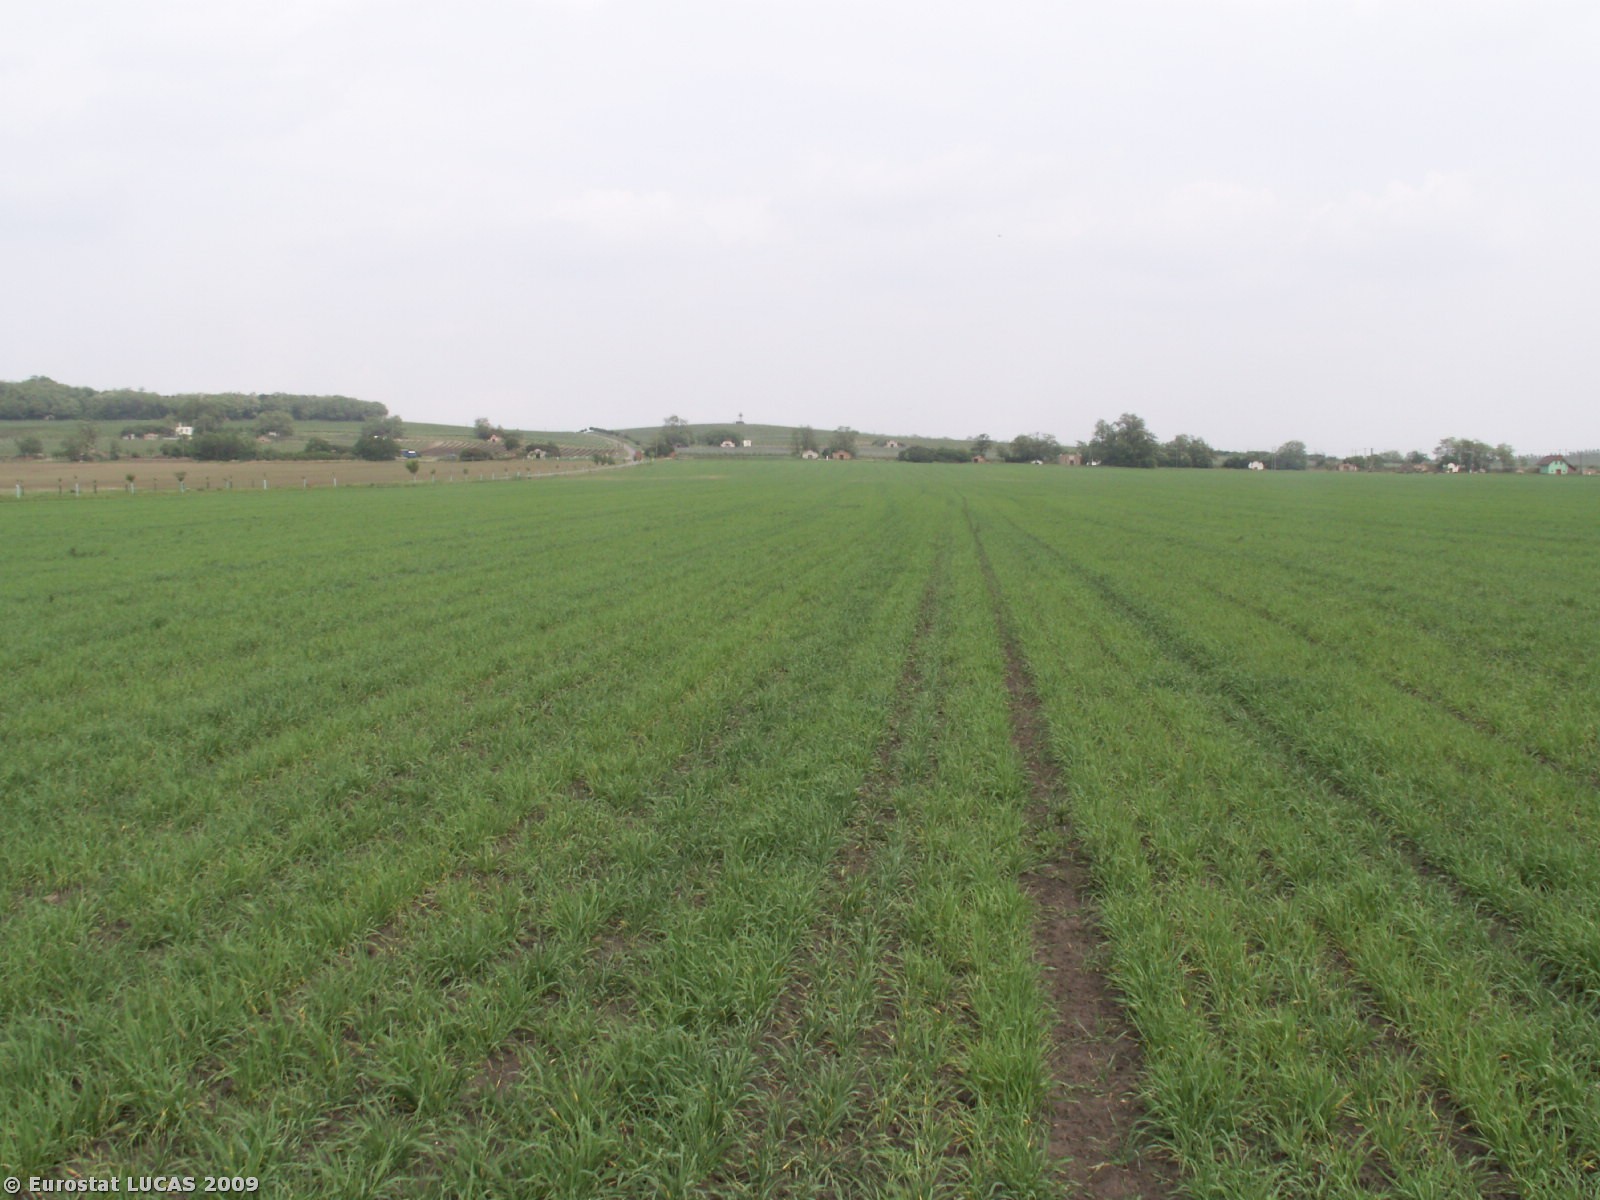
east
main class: Cropland
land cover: Barley
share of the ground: > 75 %
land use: Agriculture (excluding fallow land and kitchen gardens)
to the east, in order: Barley
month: May
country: CZ
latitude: 48.8077
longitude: 16.5015
